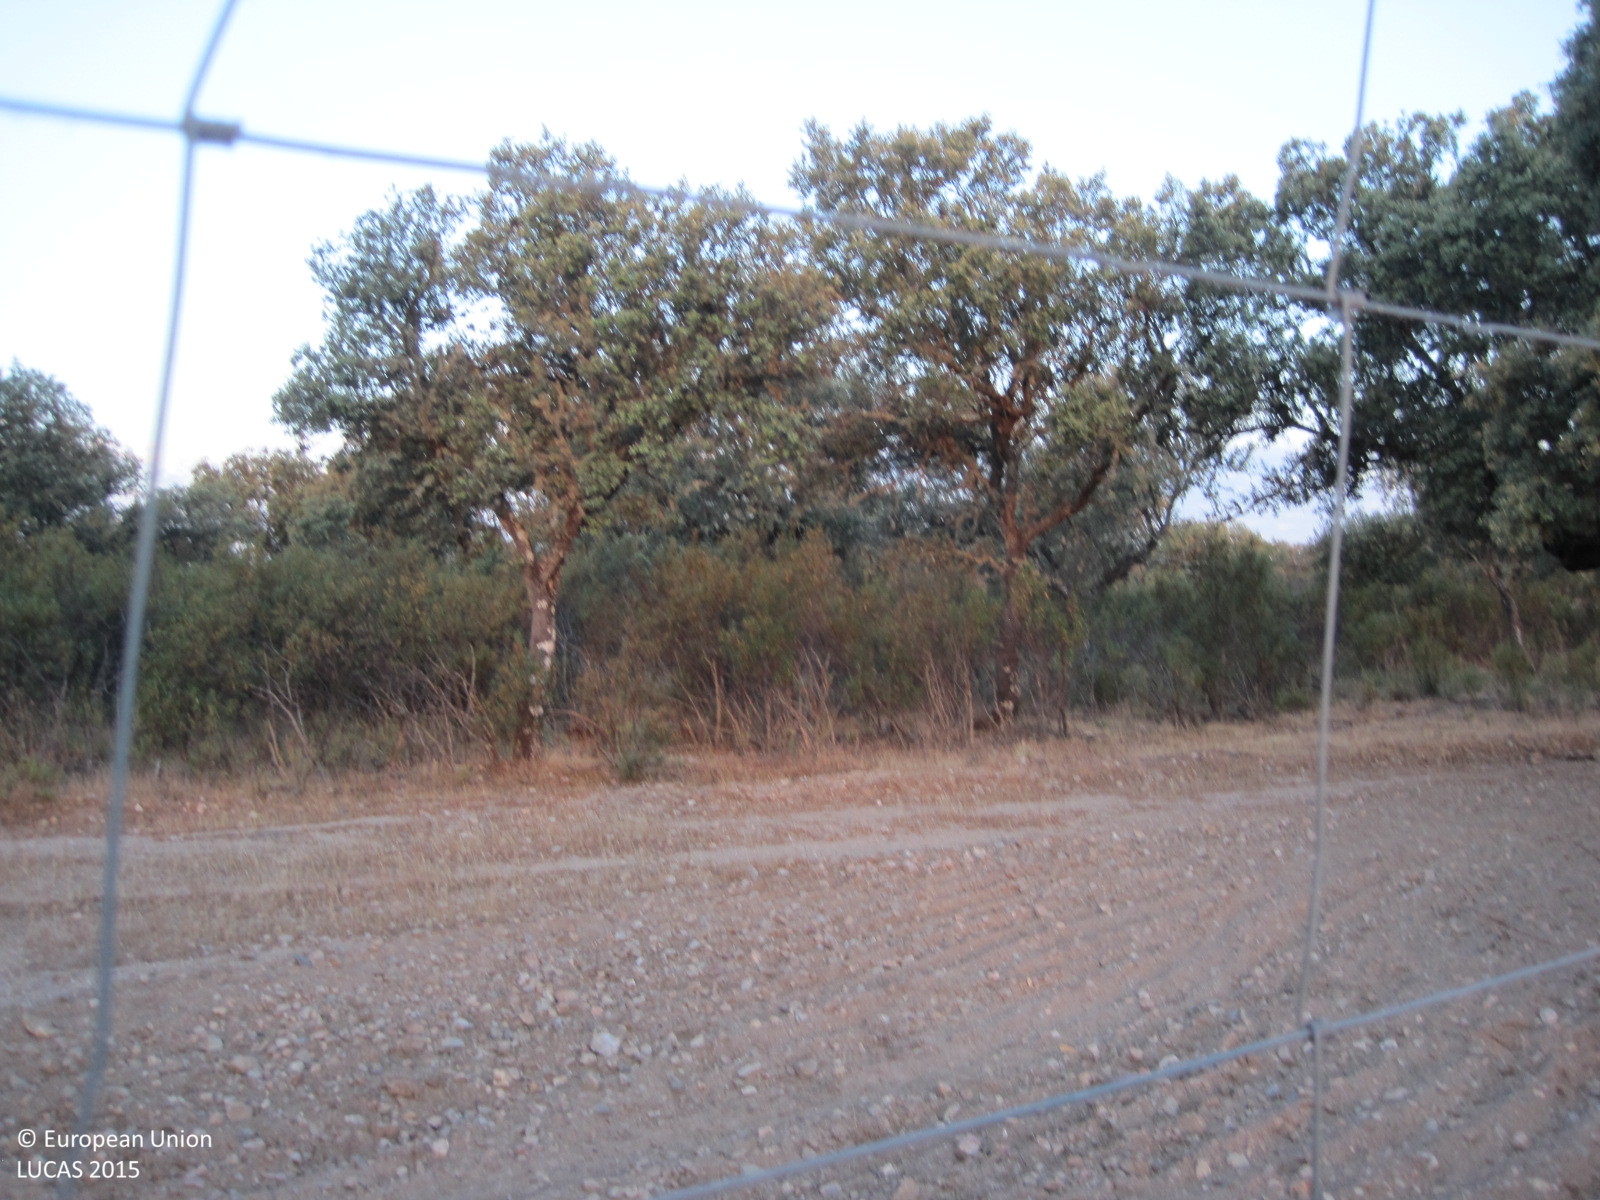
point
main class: Woodland
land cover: Broadleaved woodland
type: broadleaved evergreen forest
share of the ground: > 75 %
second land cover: Shrubland without tree cover
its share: 50 - 75 %
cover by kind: broadleaved forest trees 75 %, shrubs 20 %, herbaceous plants 5 %
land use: Forestry
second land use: Agriculture (excluding fallow land and kitchen gardens)
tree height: < 5 m
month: June
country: ES
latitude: 40.0544
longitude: -5.1651
